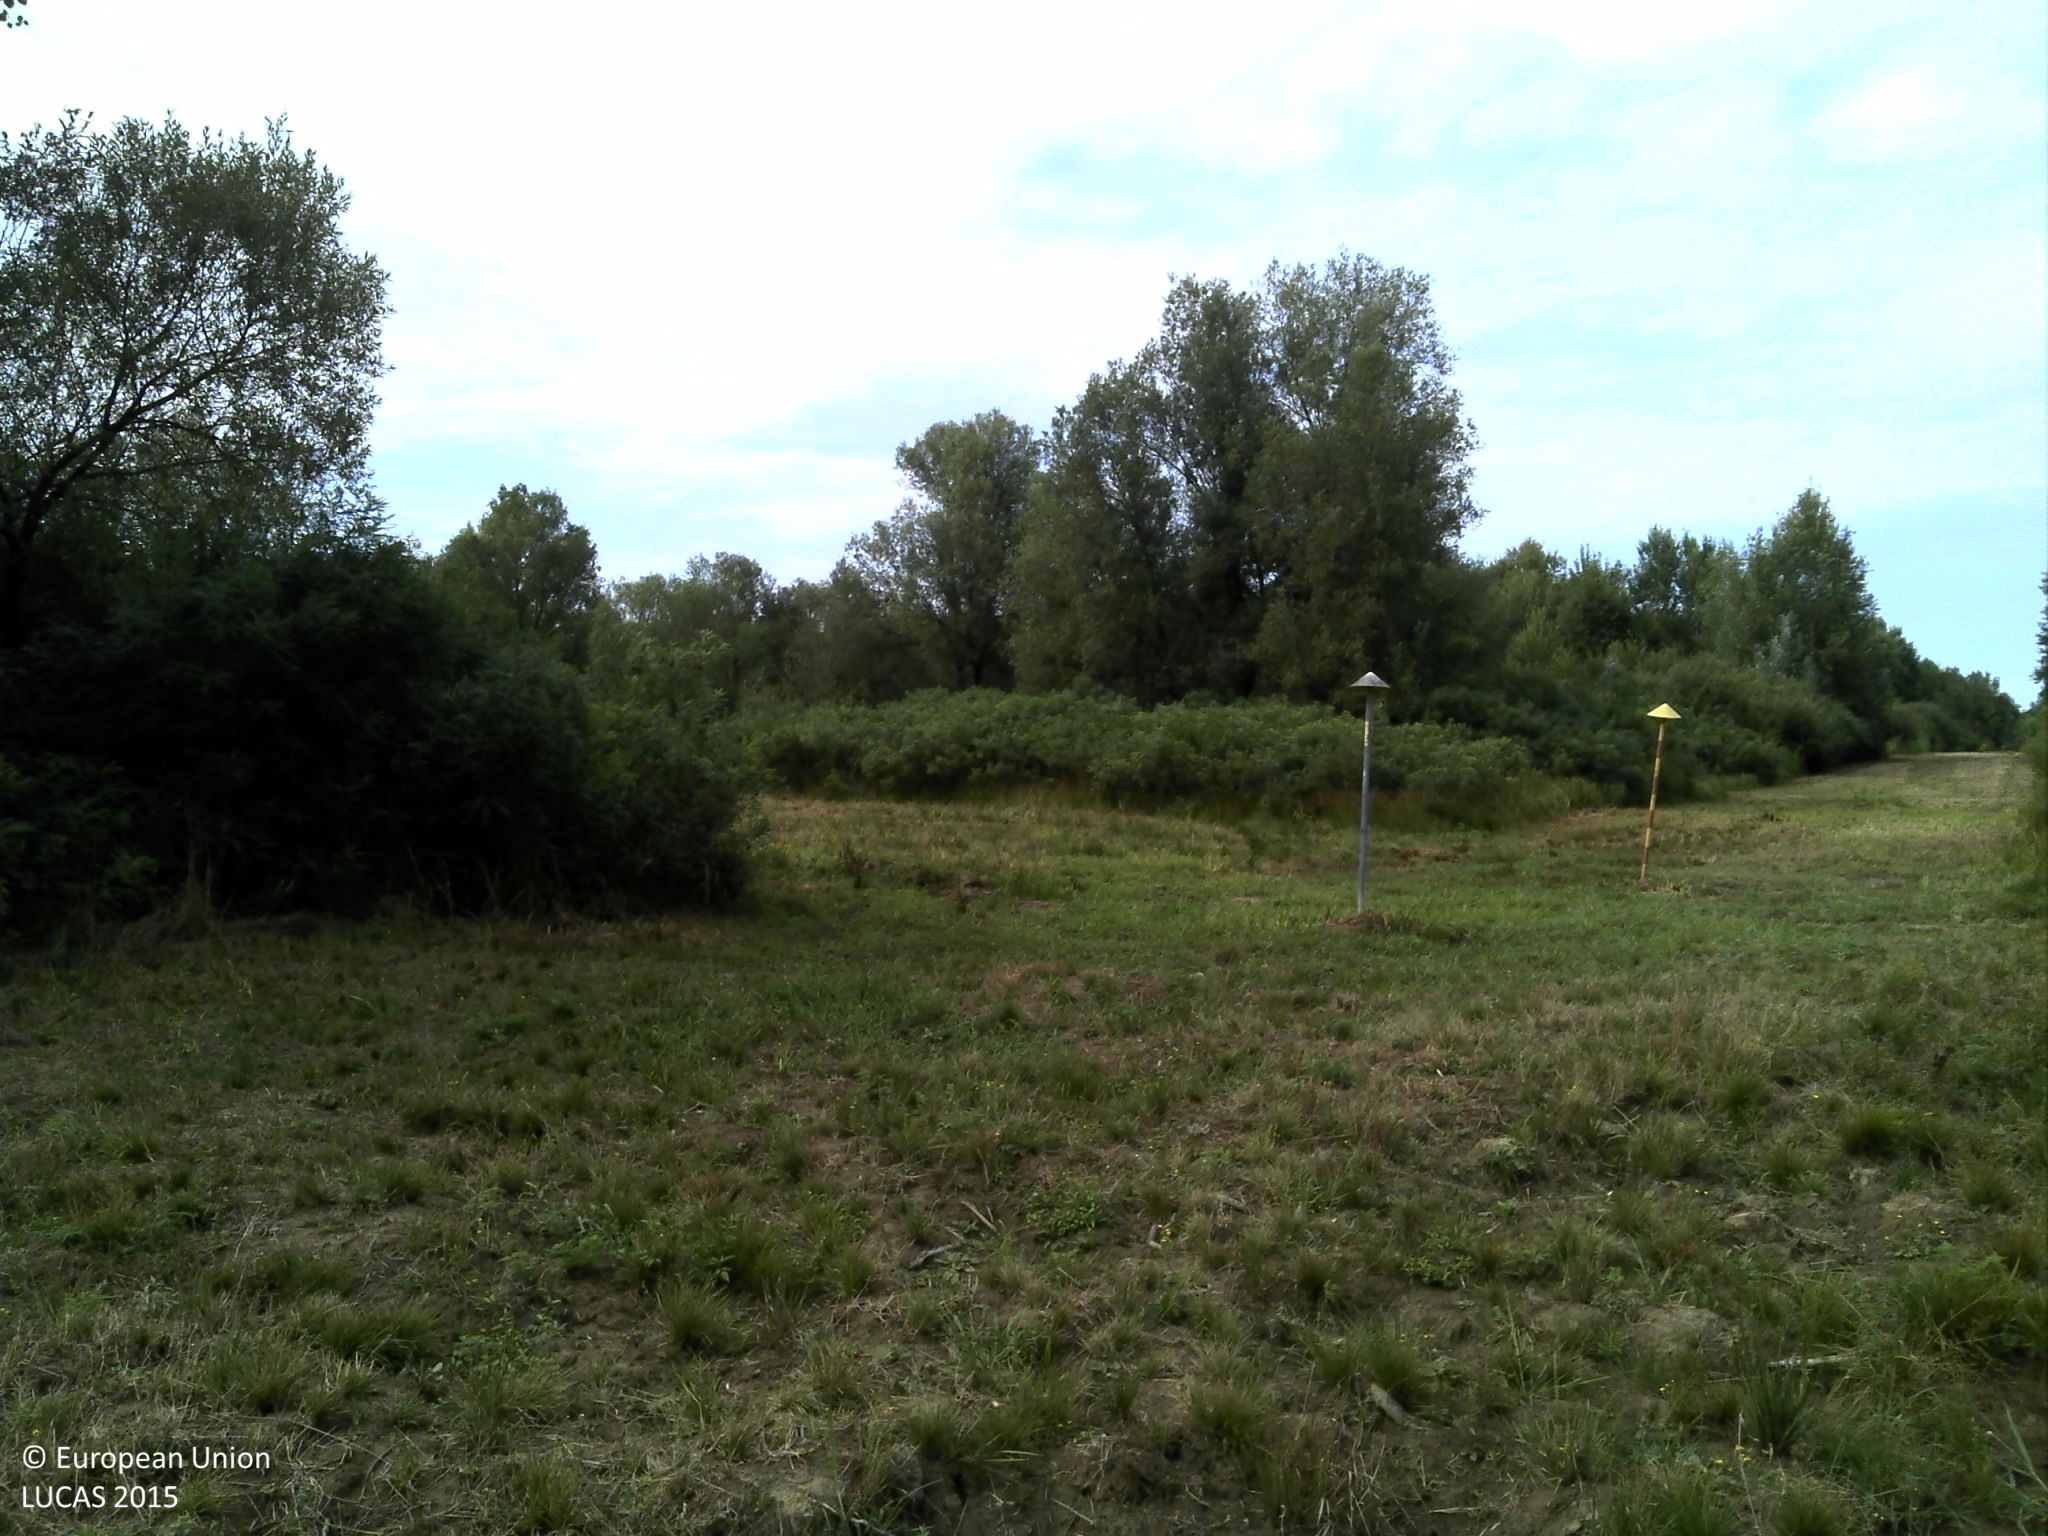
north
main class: Grassland
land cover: Grassland with sparse tree/shrub cover
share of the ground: > 75 %
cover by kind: herbaceous plants 90 %, broadleaved forest trees 5 %, shrubs 5 %
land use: Semi-natural and natural areas not in use
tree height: < 5 m
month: July
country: HR
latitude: 45.6082
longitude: 16.5508
